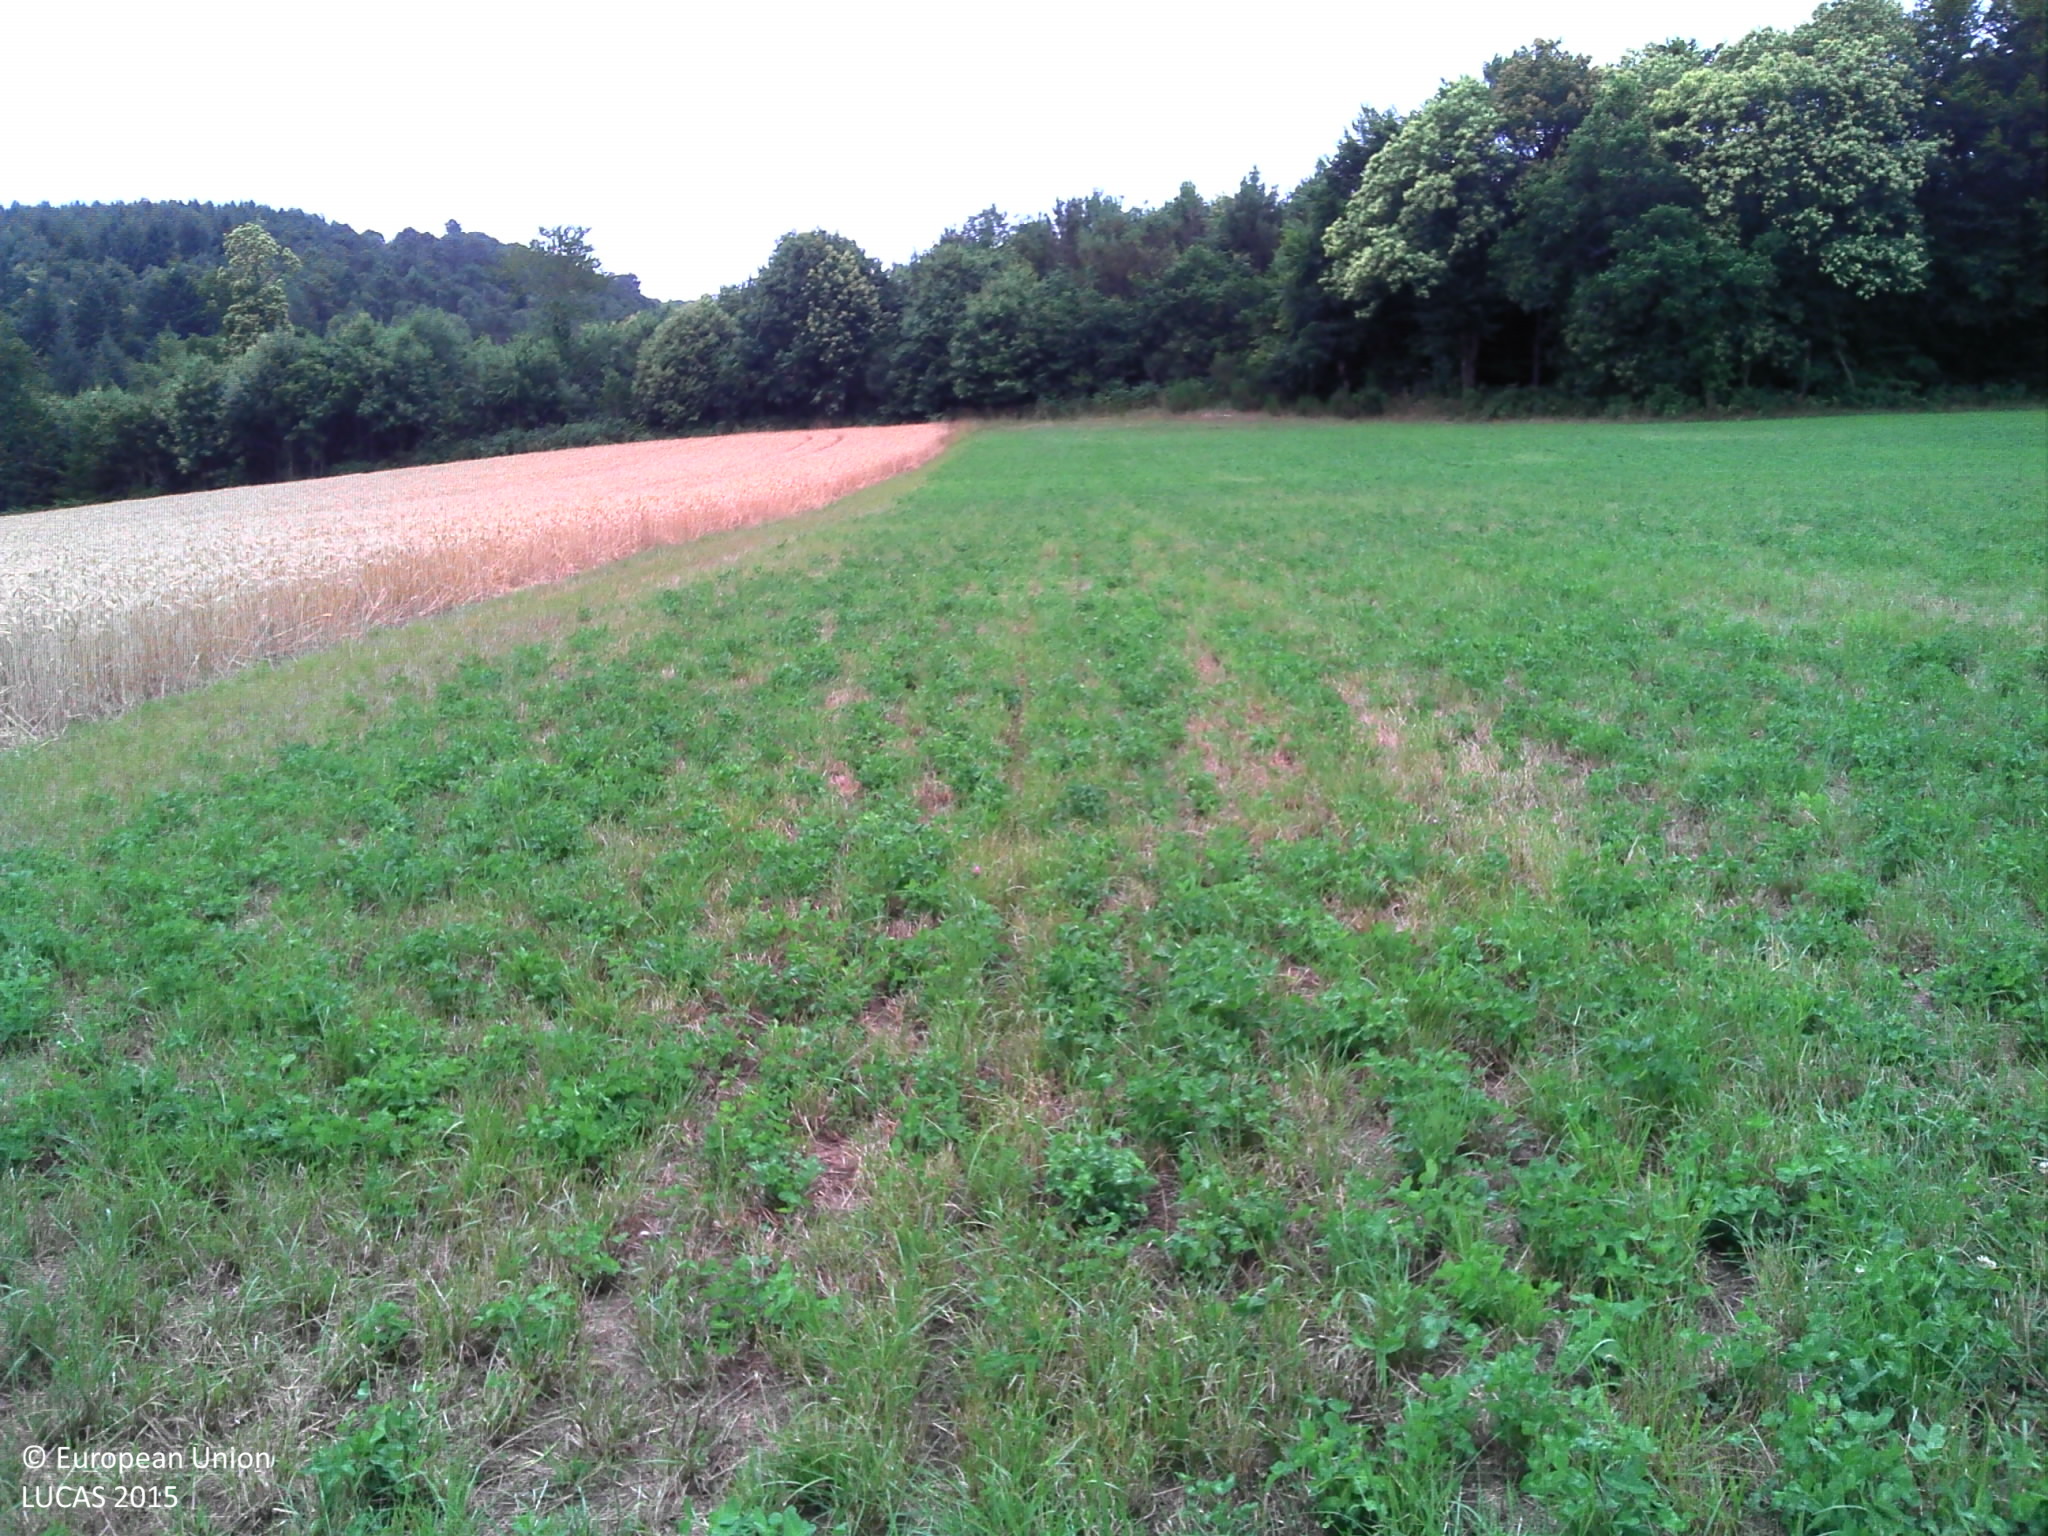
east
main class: Cropland
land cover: Temporary grasslands
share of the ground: > 75 %
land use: Agriculture (excluding fallow land and kitchen gardens)
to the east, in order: Temporary grasslands; Common wheat; Broadleaved woodland; Paved roads, cycling and walking lanes; Broadleaved woodland
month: July
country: FR
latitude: 47.8441
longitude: -3.2058
